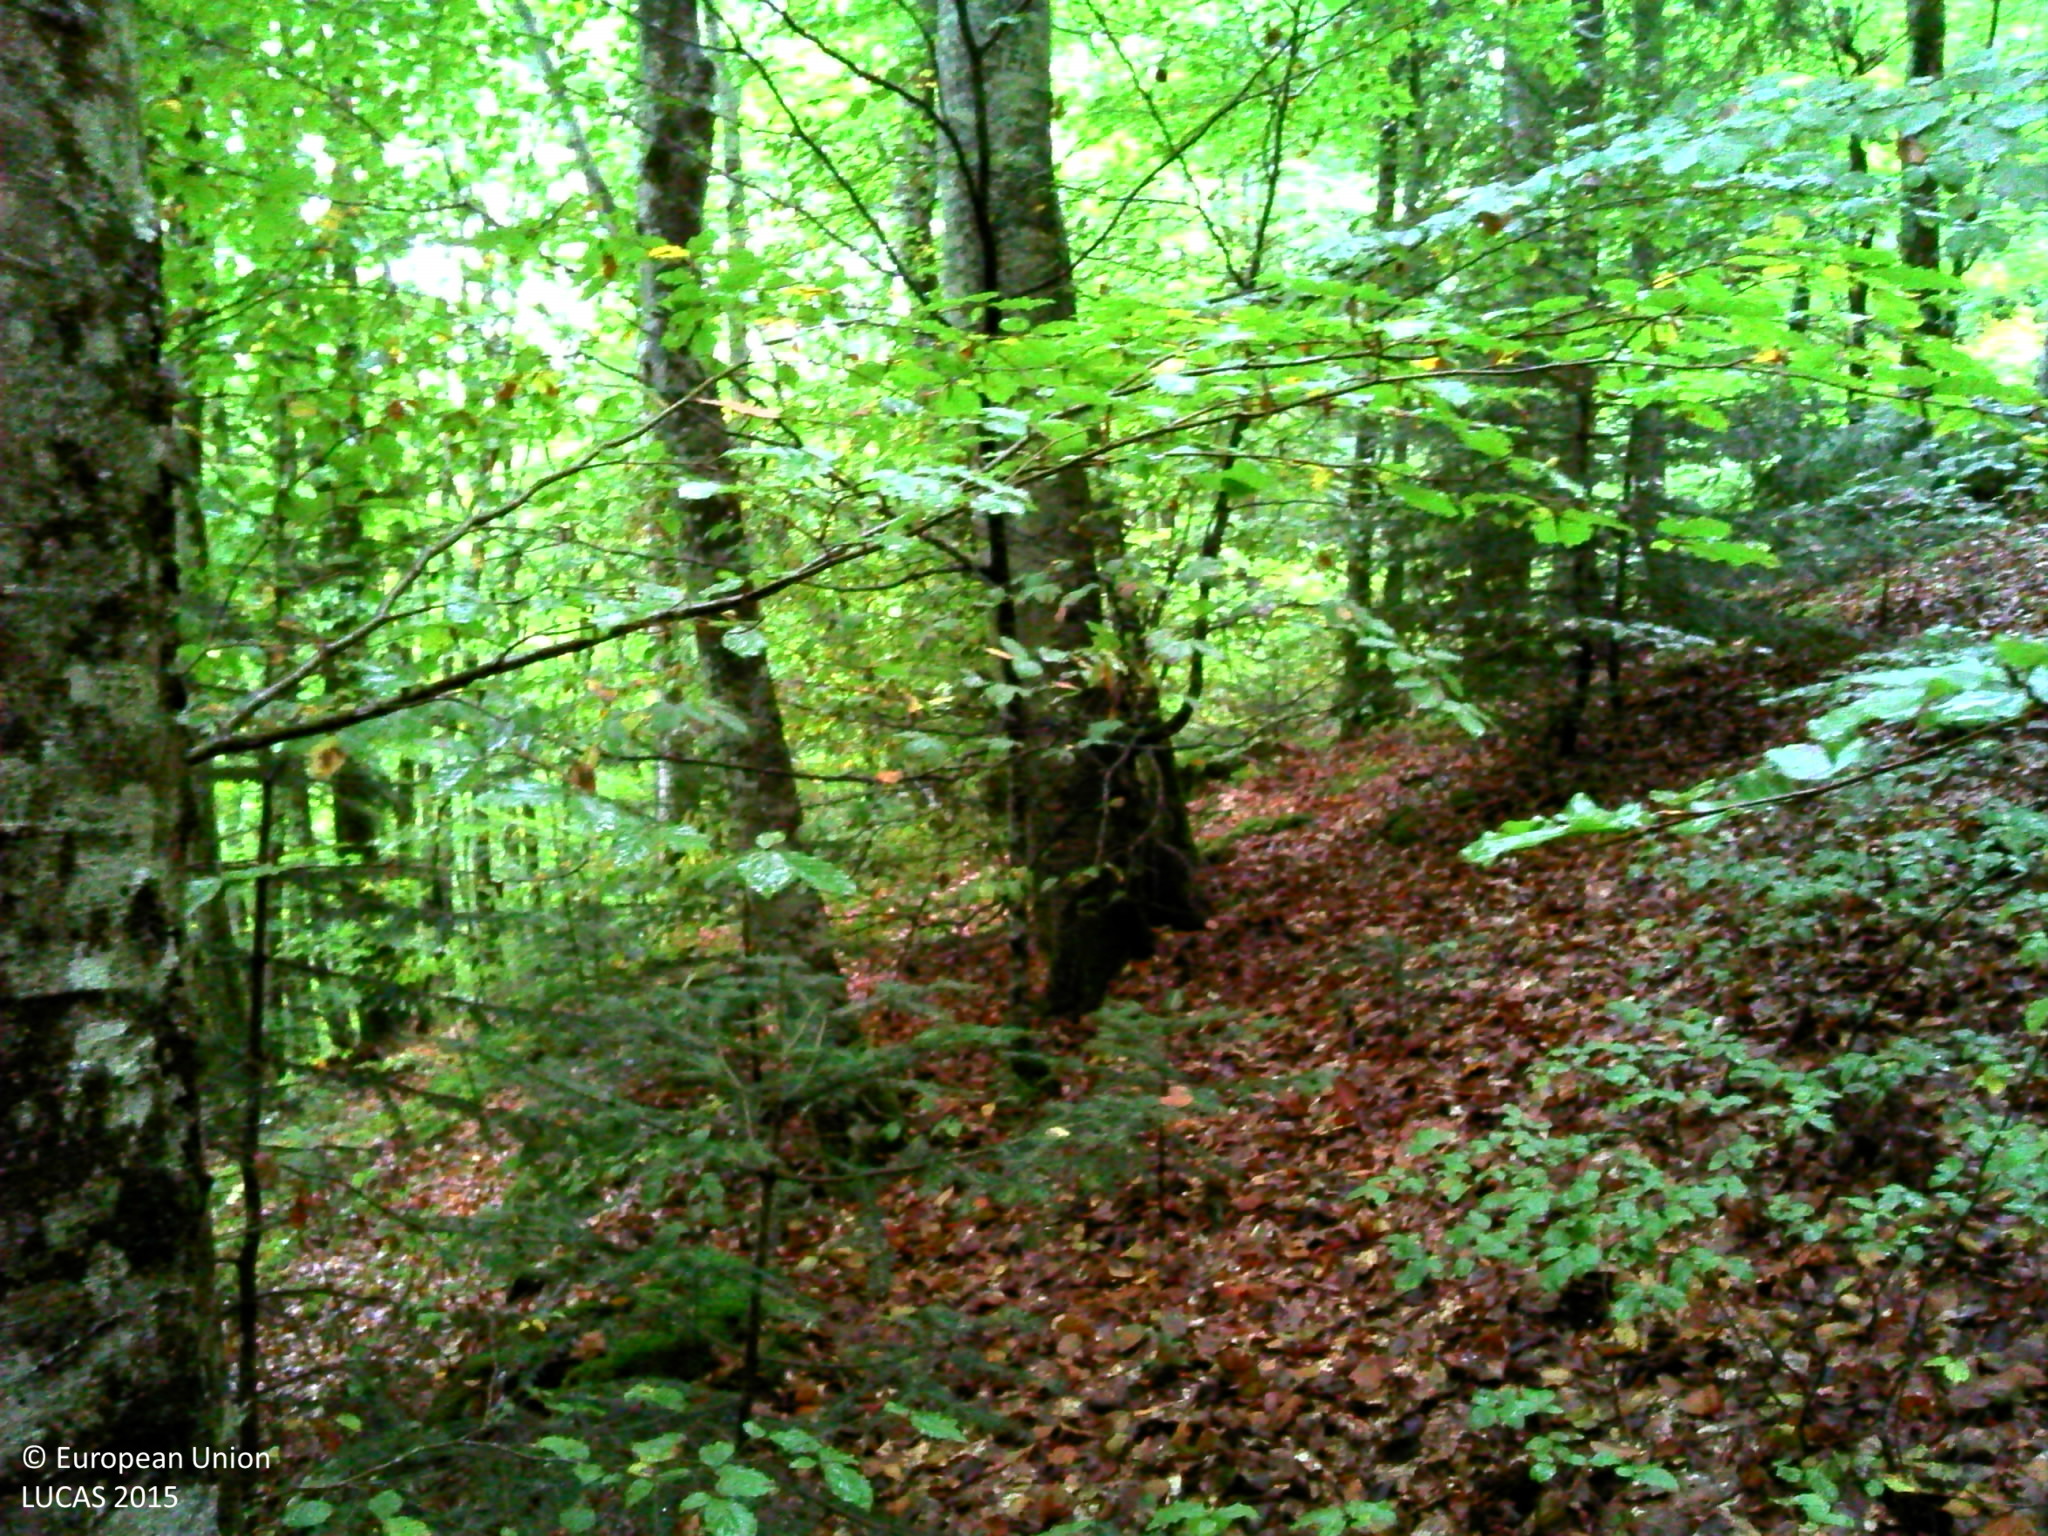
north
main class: Woodland
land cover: Broadleaved woodland
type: mountainous beech forest
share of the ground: > 75 %
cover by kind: broadleaved forest trees 80 %, coniferous forest trees 10 %, herbaceous plants 5 %, lichens and mosses 5 %
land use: Forestry
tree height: > 5 m
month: October
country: FR
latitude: 45.9108
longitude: 3.6712
